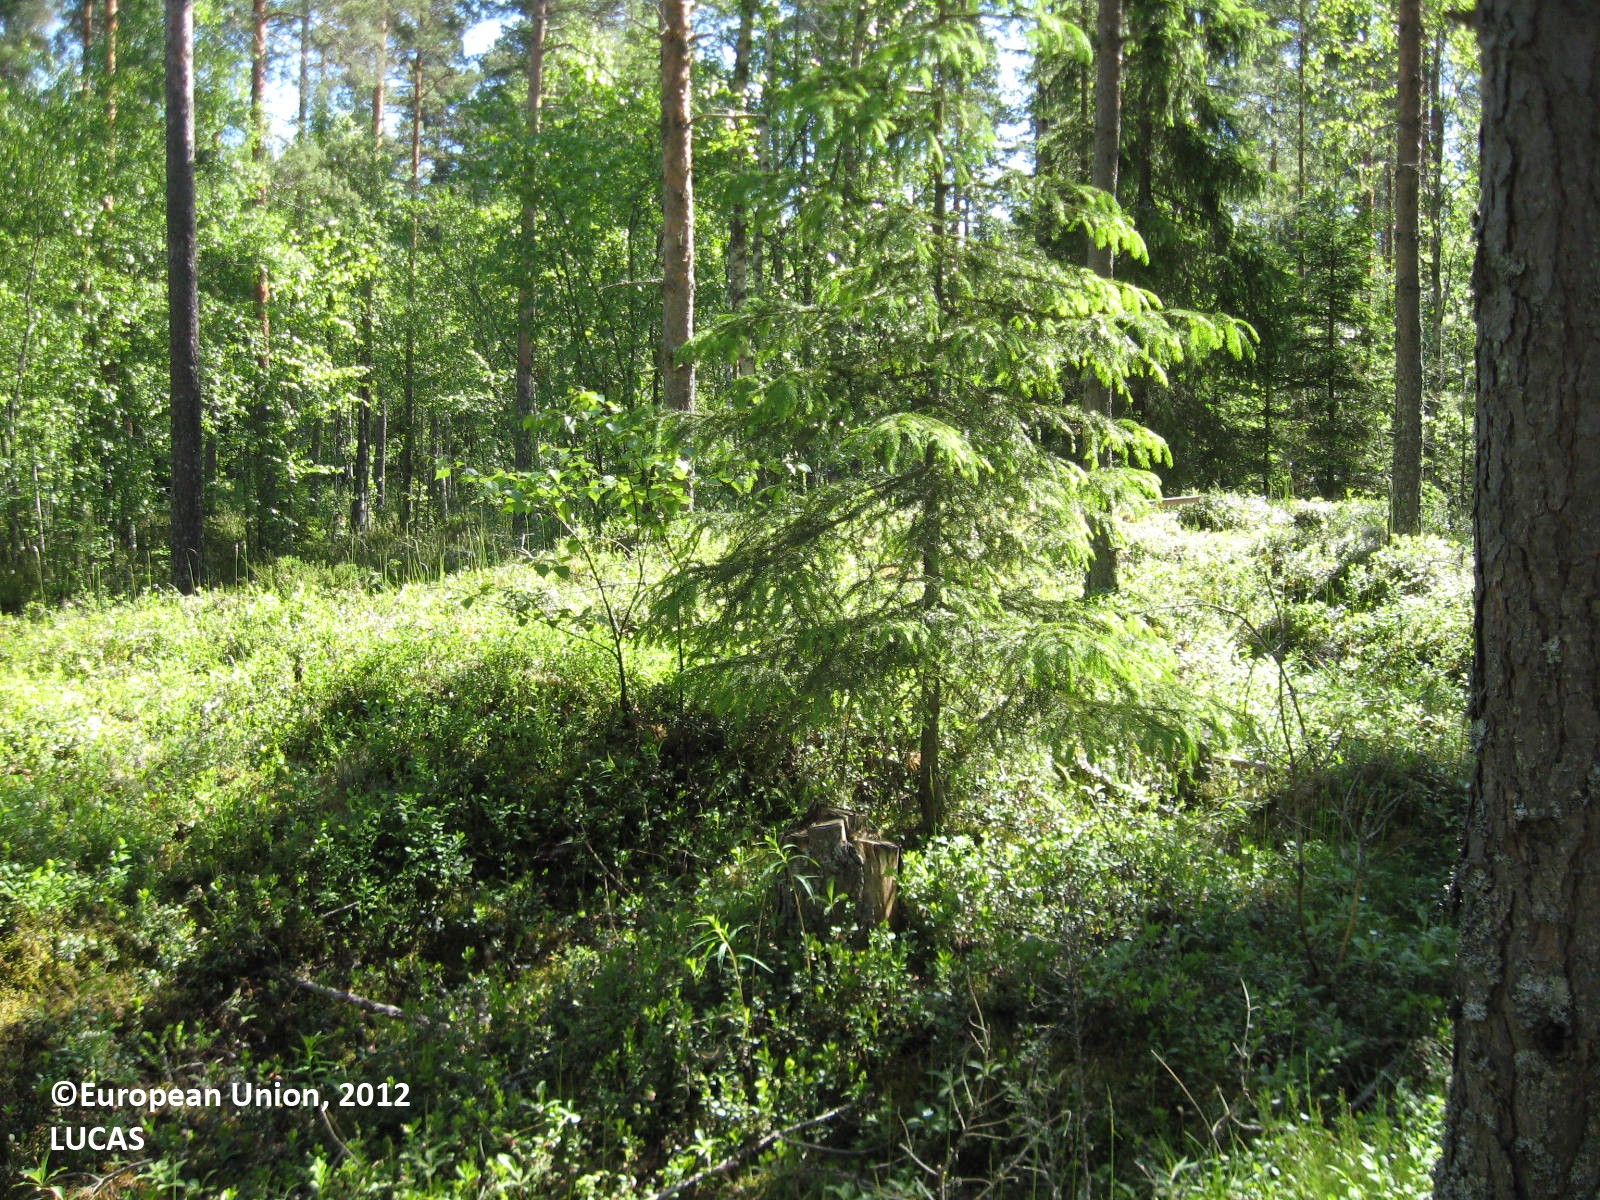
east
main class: Woodland
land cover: Pine dominated coniferous woodland
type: boreal forest
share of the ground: > 75 %
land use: Forestry
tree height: > 5 m
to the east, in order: Pine dominated coniferous woodland; Ditches and canals; Pine dominated coniferous woodland; Ditches and canals; Pine dominated coniferous woodland; Grass margins; Pine dominated coniferous woodland; Ditches and canals; Other coniferous woodland
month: June
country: FI
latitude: 62.8317
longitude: 21.6839
